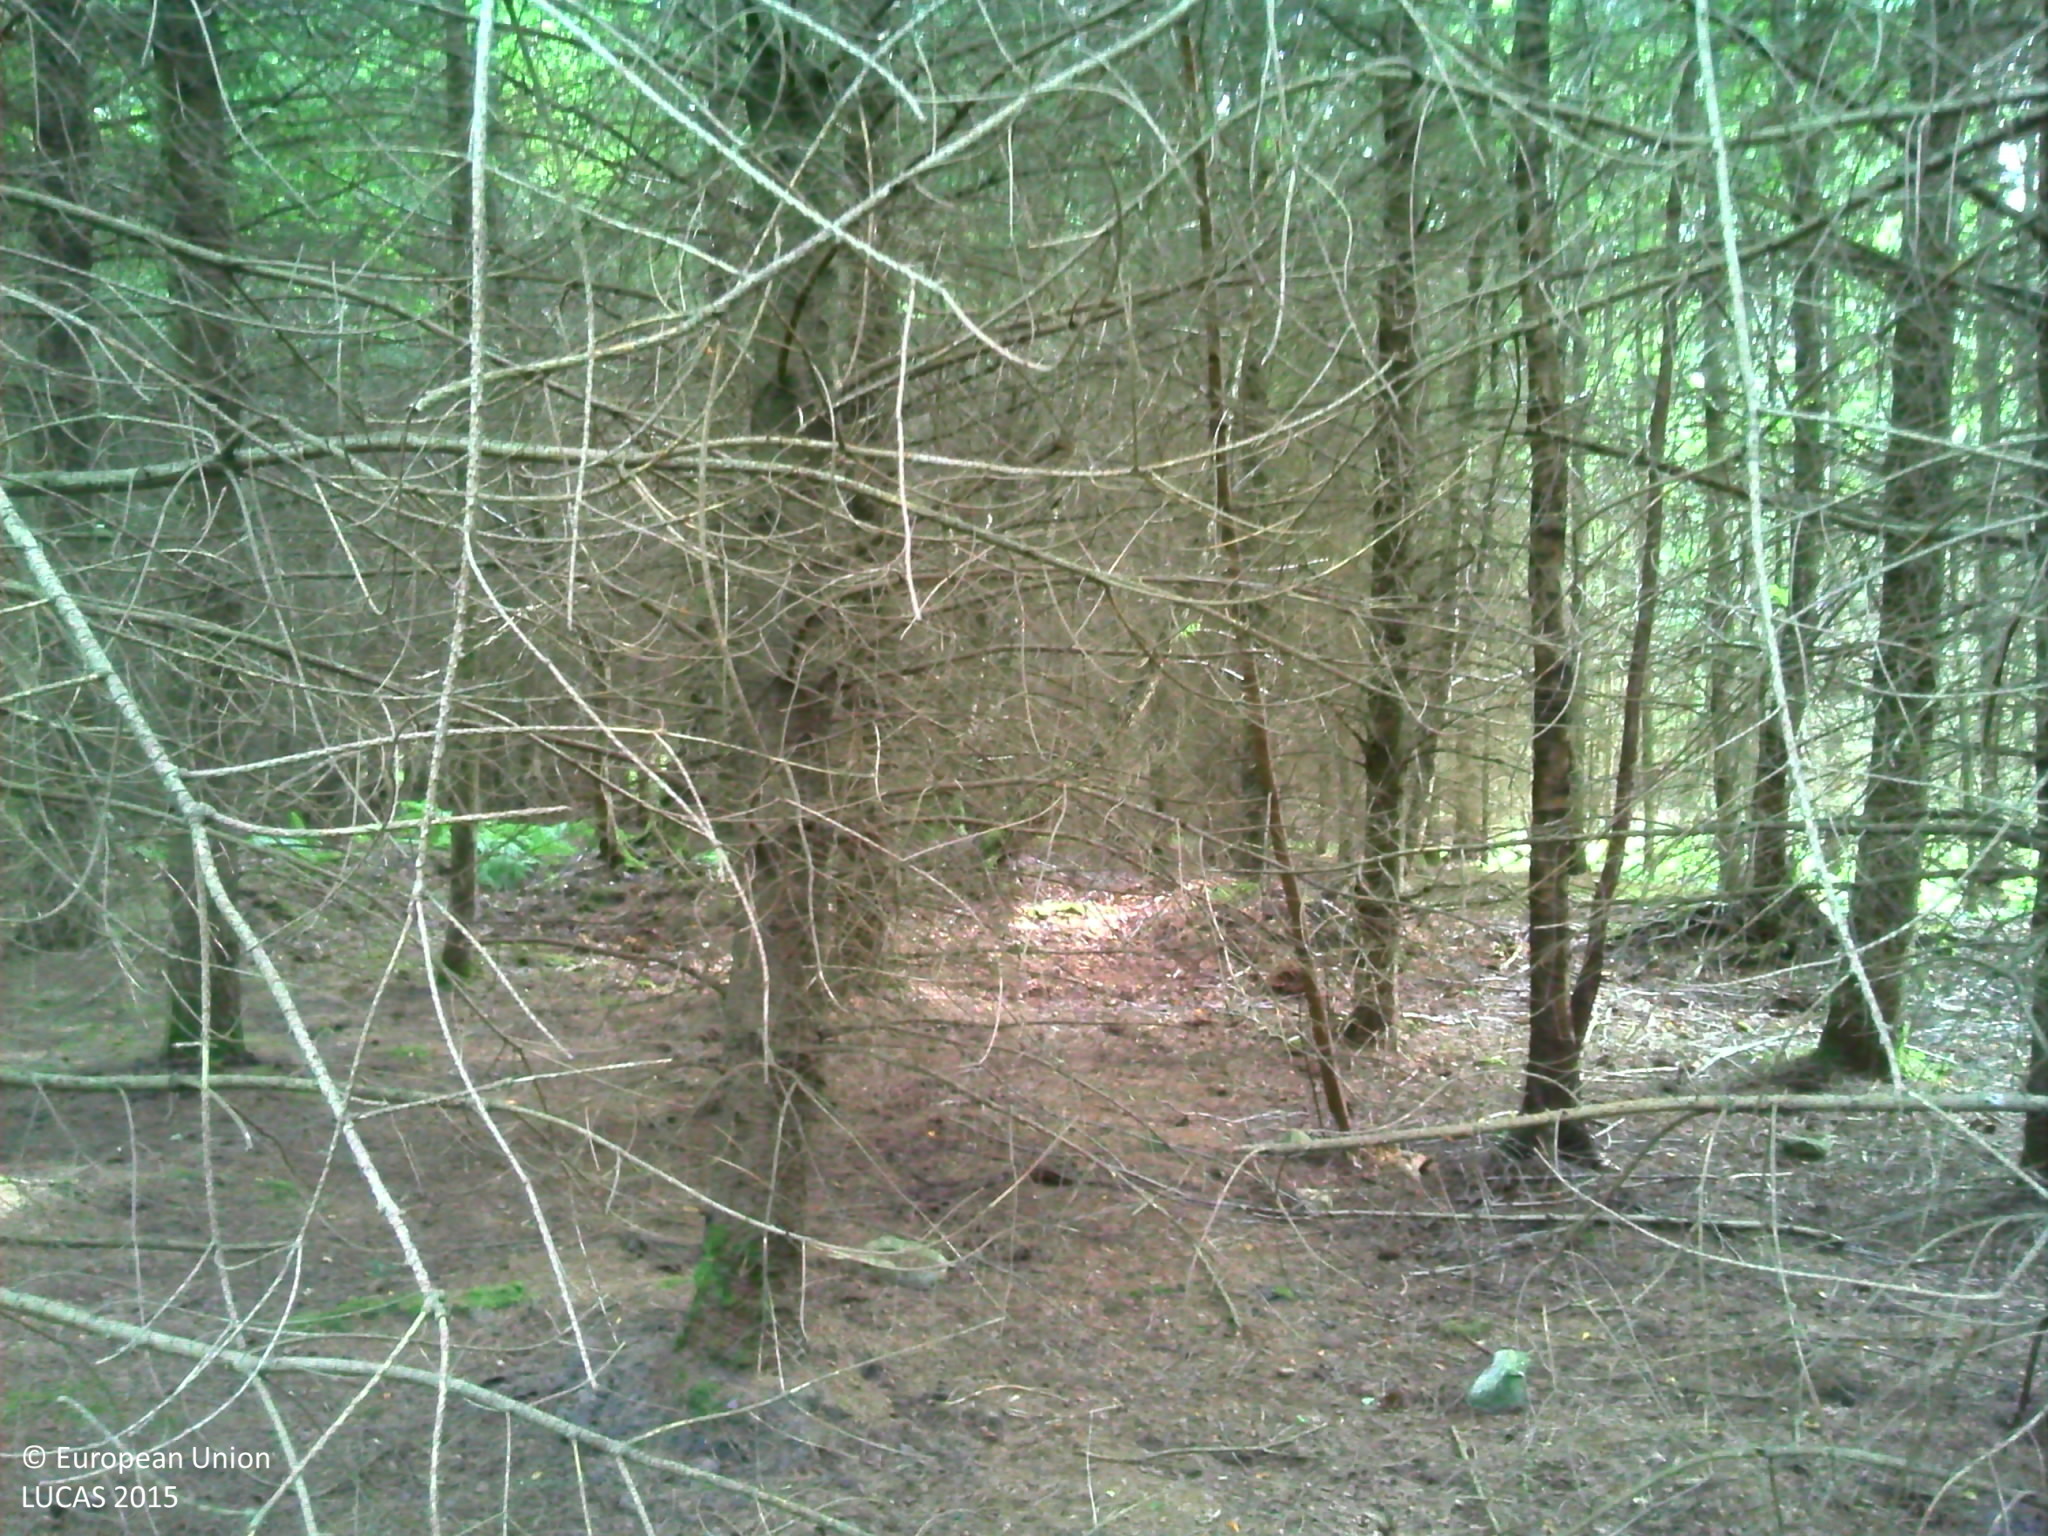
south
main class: Woodland
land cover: Spruce dominated coniferous woodland
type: mesophytic deciduous forest
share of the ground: > 75 %
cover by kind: coniferous forest trees 95 %, herbaceous plants 5 %
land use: Forestry
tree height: > 5 m
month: August
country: FR
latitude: 48.5111
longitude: -0.1976
